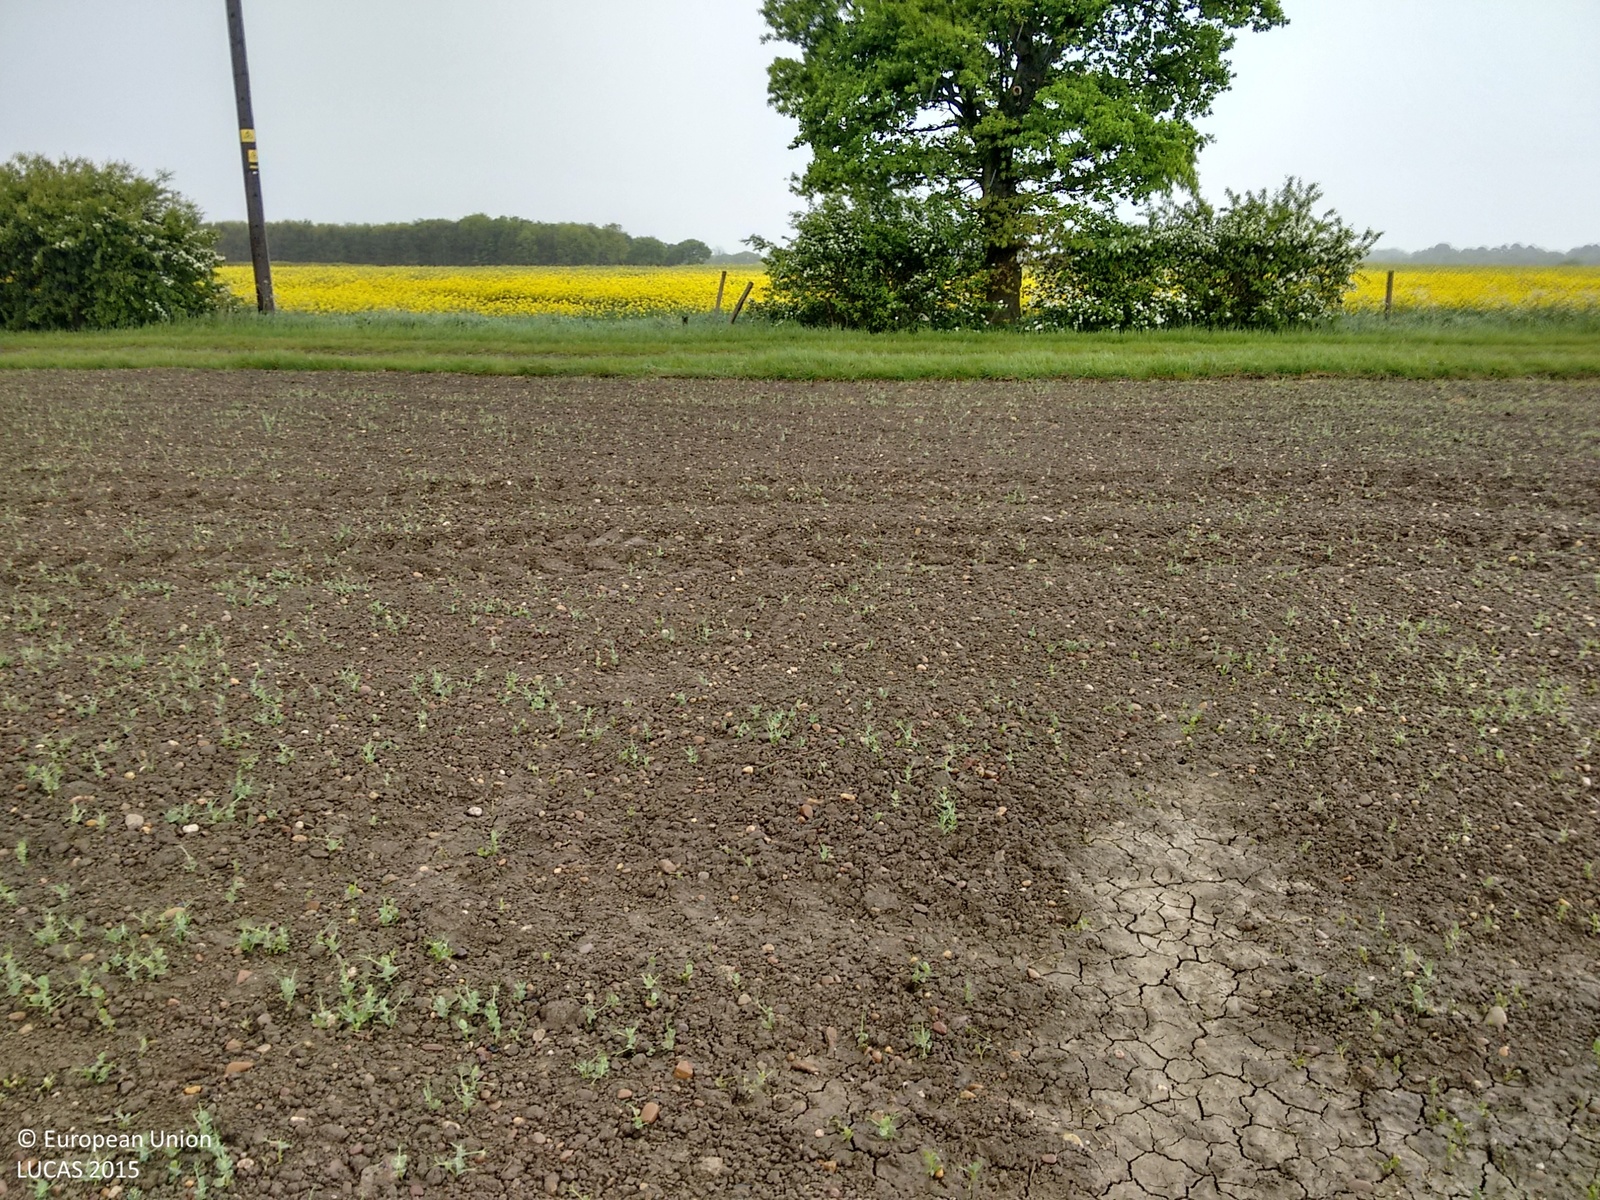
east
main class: Cropland
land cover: Dry pulses
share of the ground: 10 - 25 %
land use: Agriculture (excluding fallow land and kitchen gardens)
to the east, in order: Dry pulses; Grass margins; Tracks; Electric lines; Grass margins; Fences; Grass margins; Rape and turnip rape
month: May
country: GB
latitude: 53.5661
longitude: -1.0511
